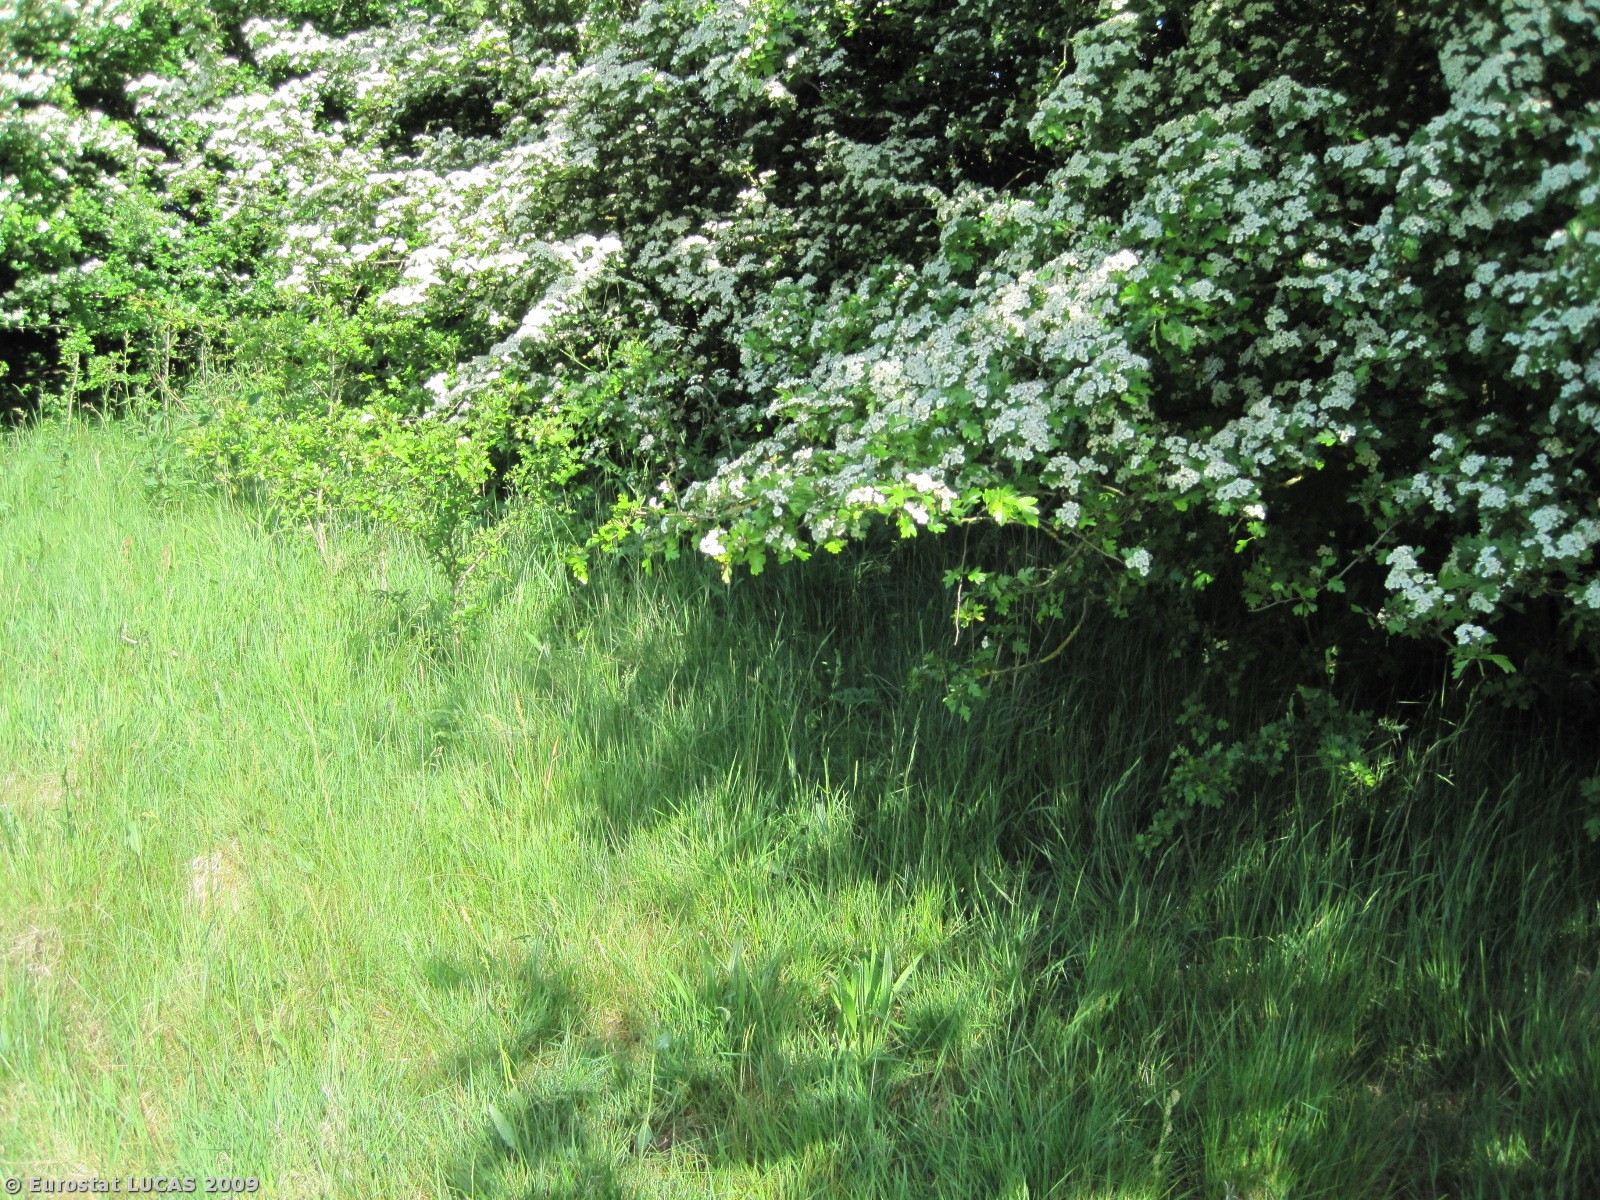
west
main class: Woodland
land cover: Broadleaved woodland
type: mesophytic deciduous forest
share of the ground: > 75 %
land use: Unused
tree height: > 5 m
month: May
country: DK
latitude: 56.5652
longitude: 10.1138
